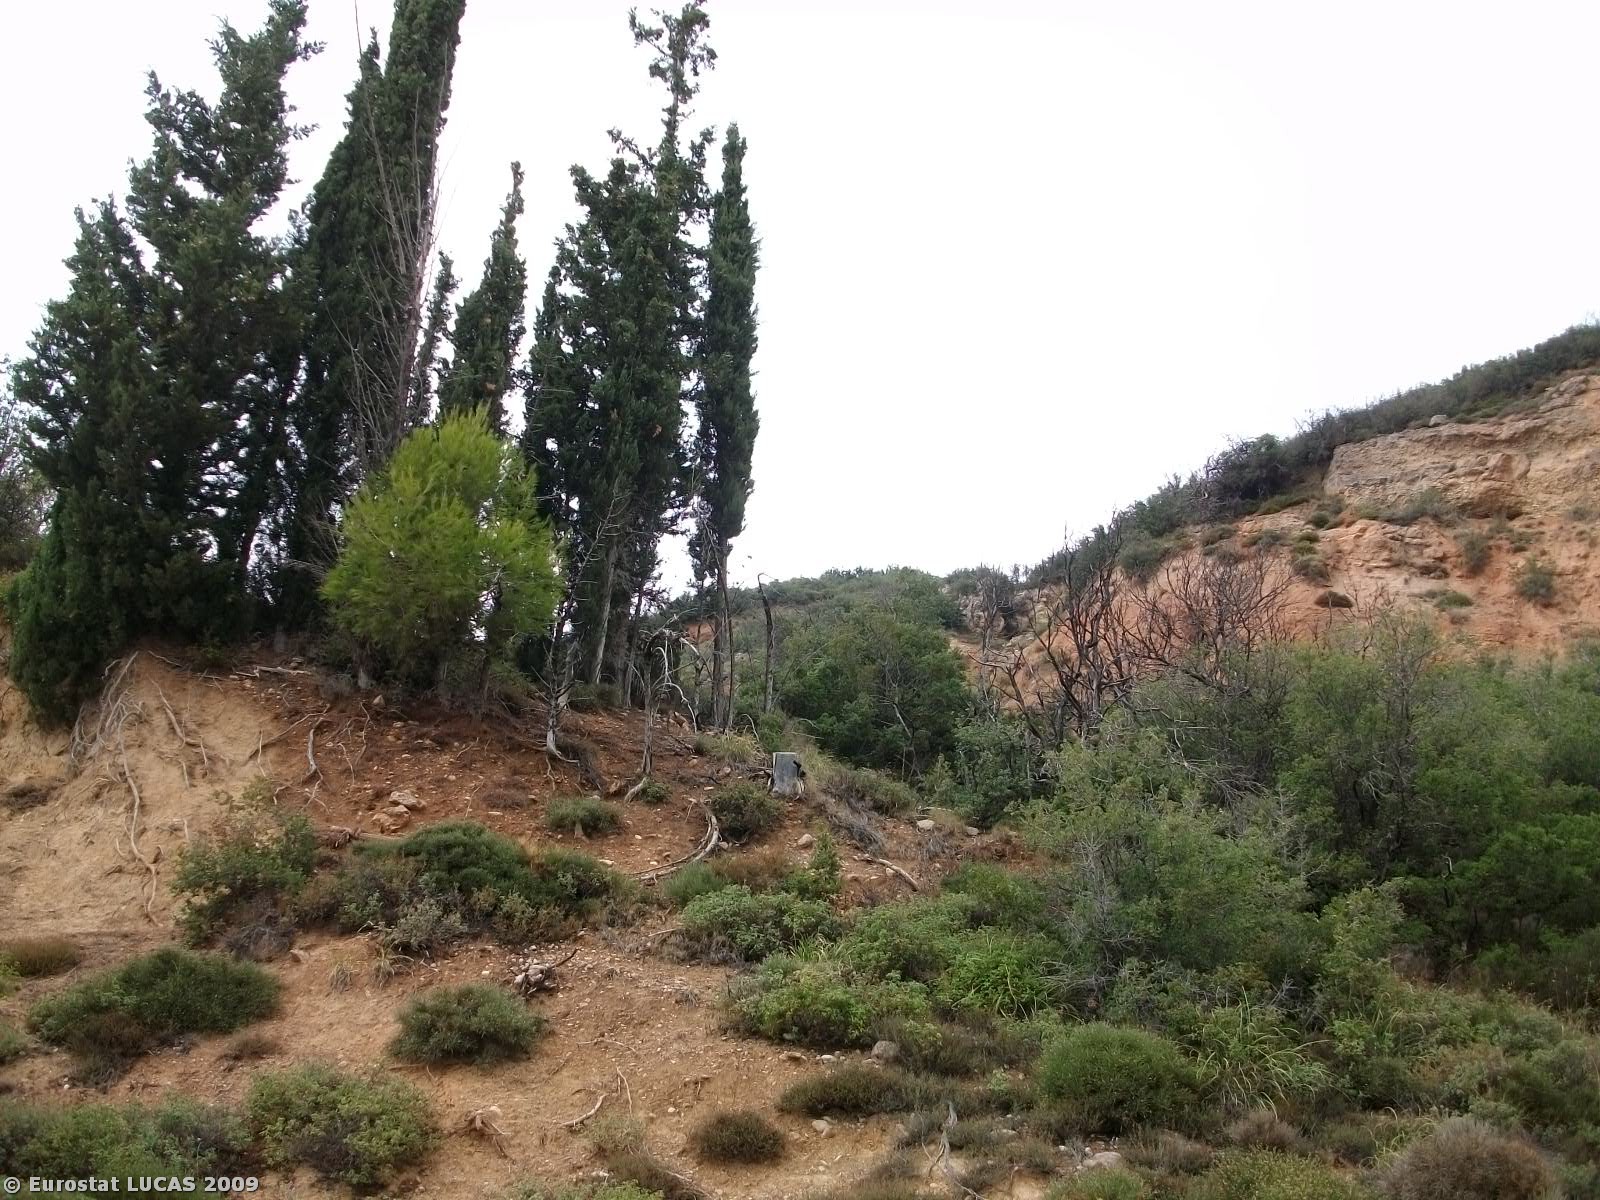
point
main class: Shrubland
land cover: Shrubland without tree cover
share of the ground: > 75 %
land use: Unused
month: September
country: GR
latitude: 38.0709
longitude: 22.5208
